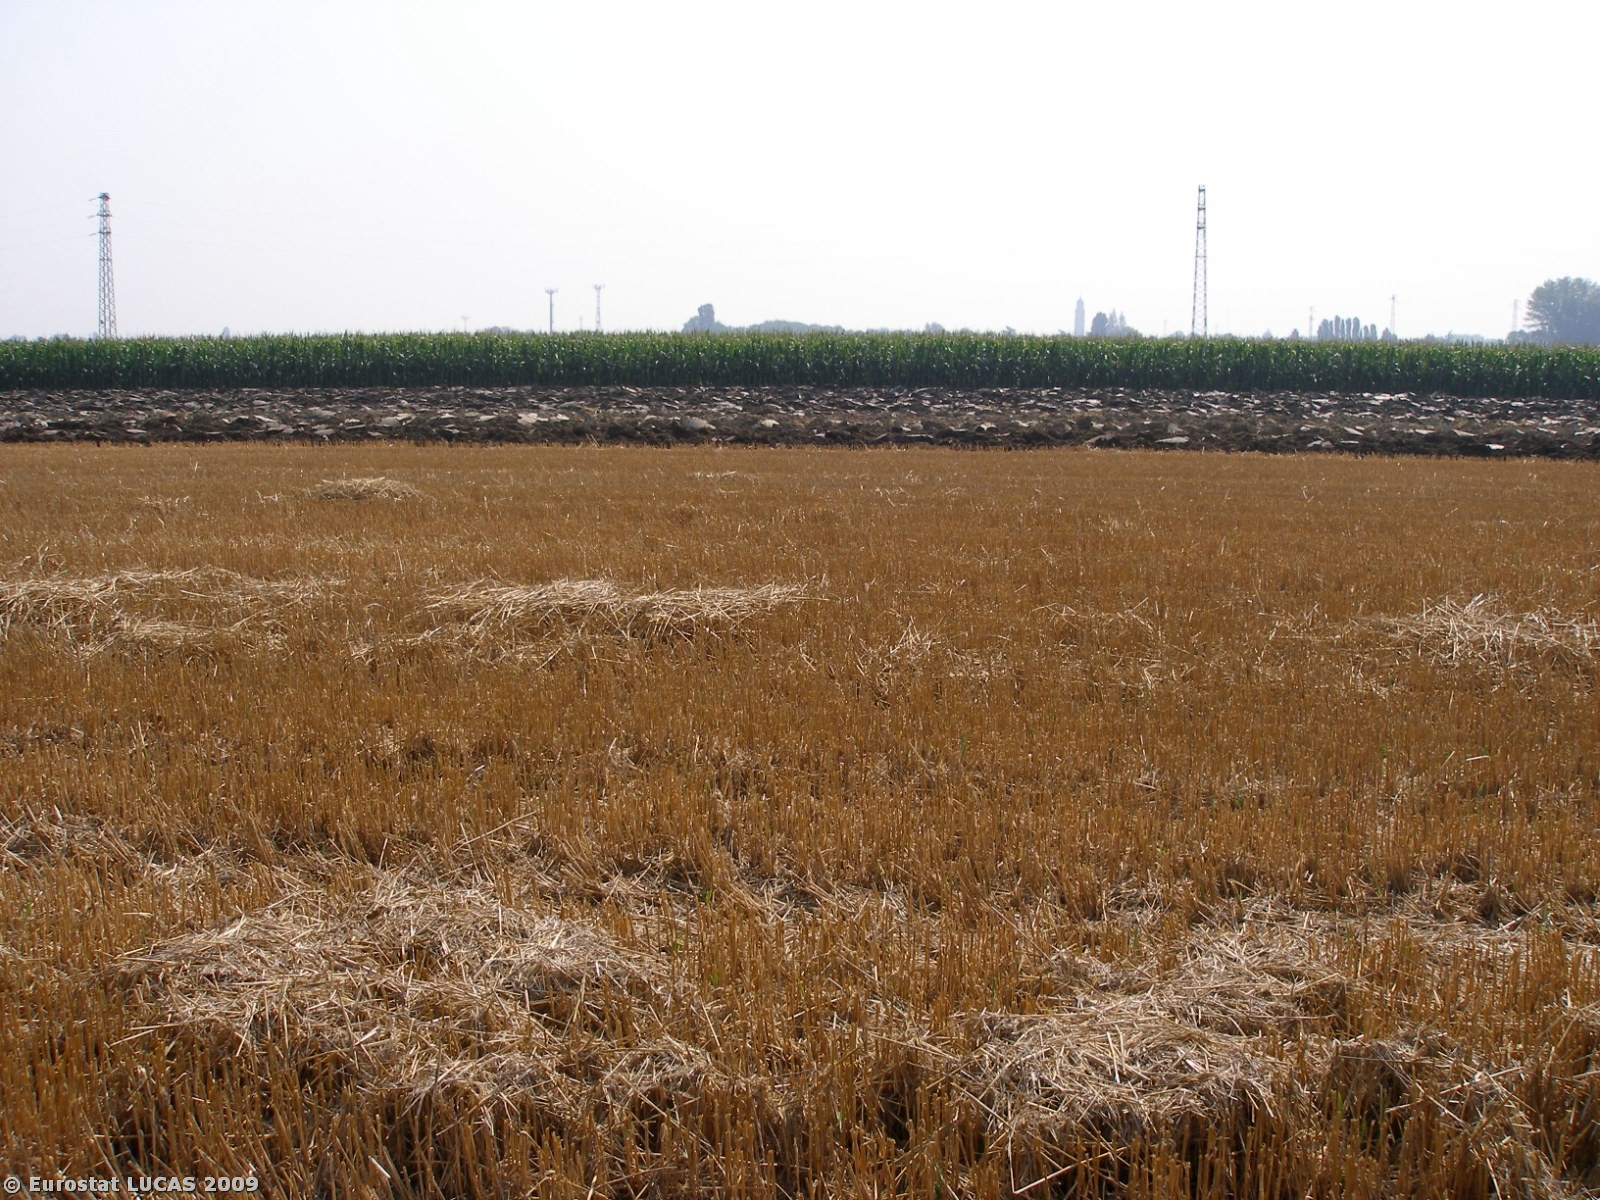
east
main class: Cropland
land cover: Common wheat
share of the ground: < 10 %
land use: Agriculture (excluding fallow land and kitchen gardens)
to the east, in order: Common wheat; Bare land; Maize; Tracks; Ditches and canals; Electric lines; Common wheat
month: July
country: IT
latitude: 44.9673
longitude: 11.7337
